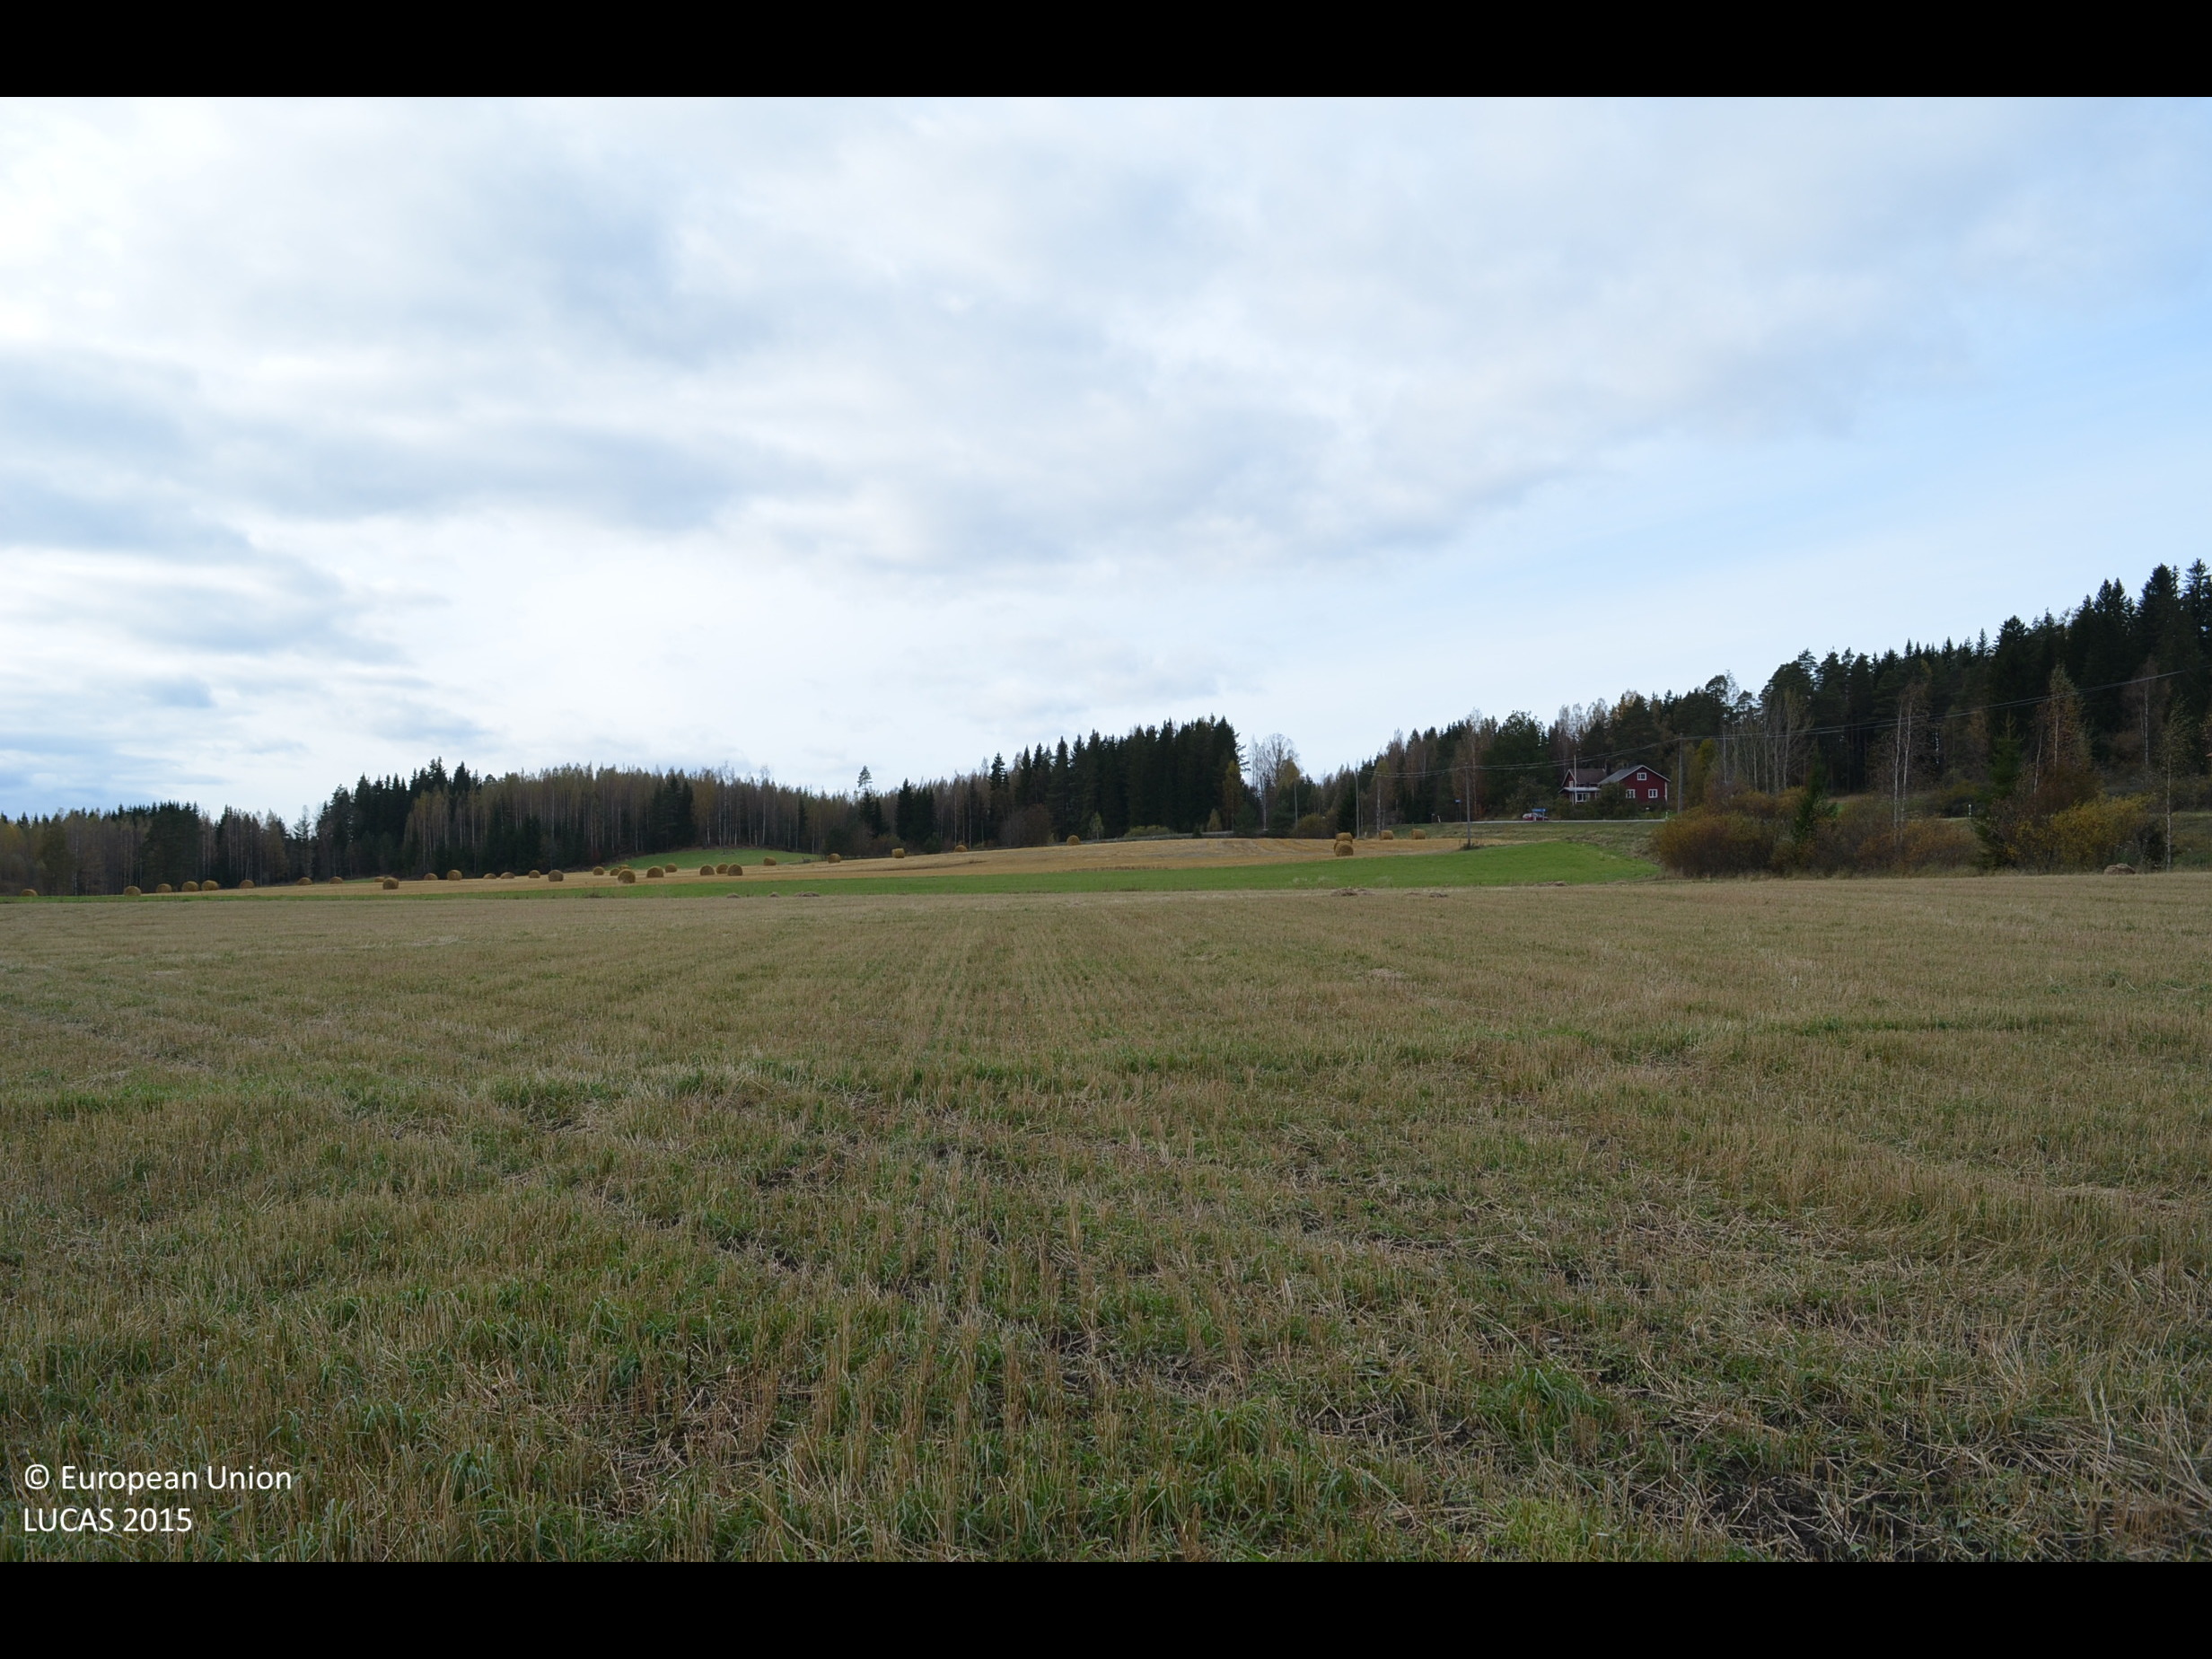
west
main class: Cropland
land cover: Barley
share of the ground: > 75 %
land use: Agriculture (excluding fallow land and kitchen gardens)
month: October
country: FI
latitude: 61.4996
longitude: 23.1679
